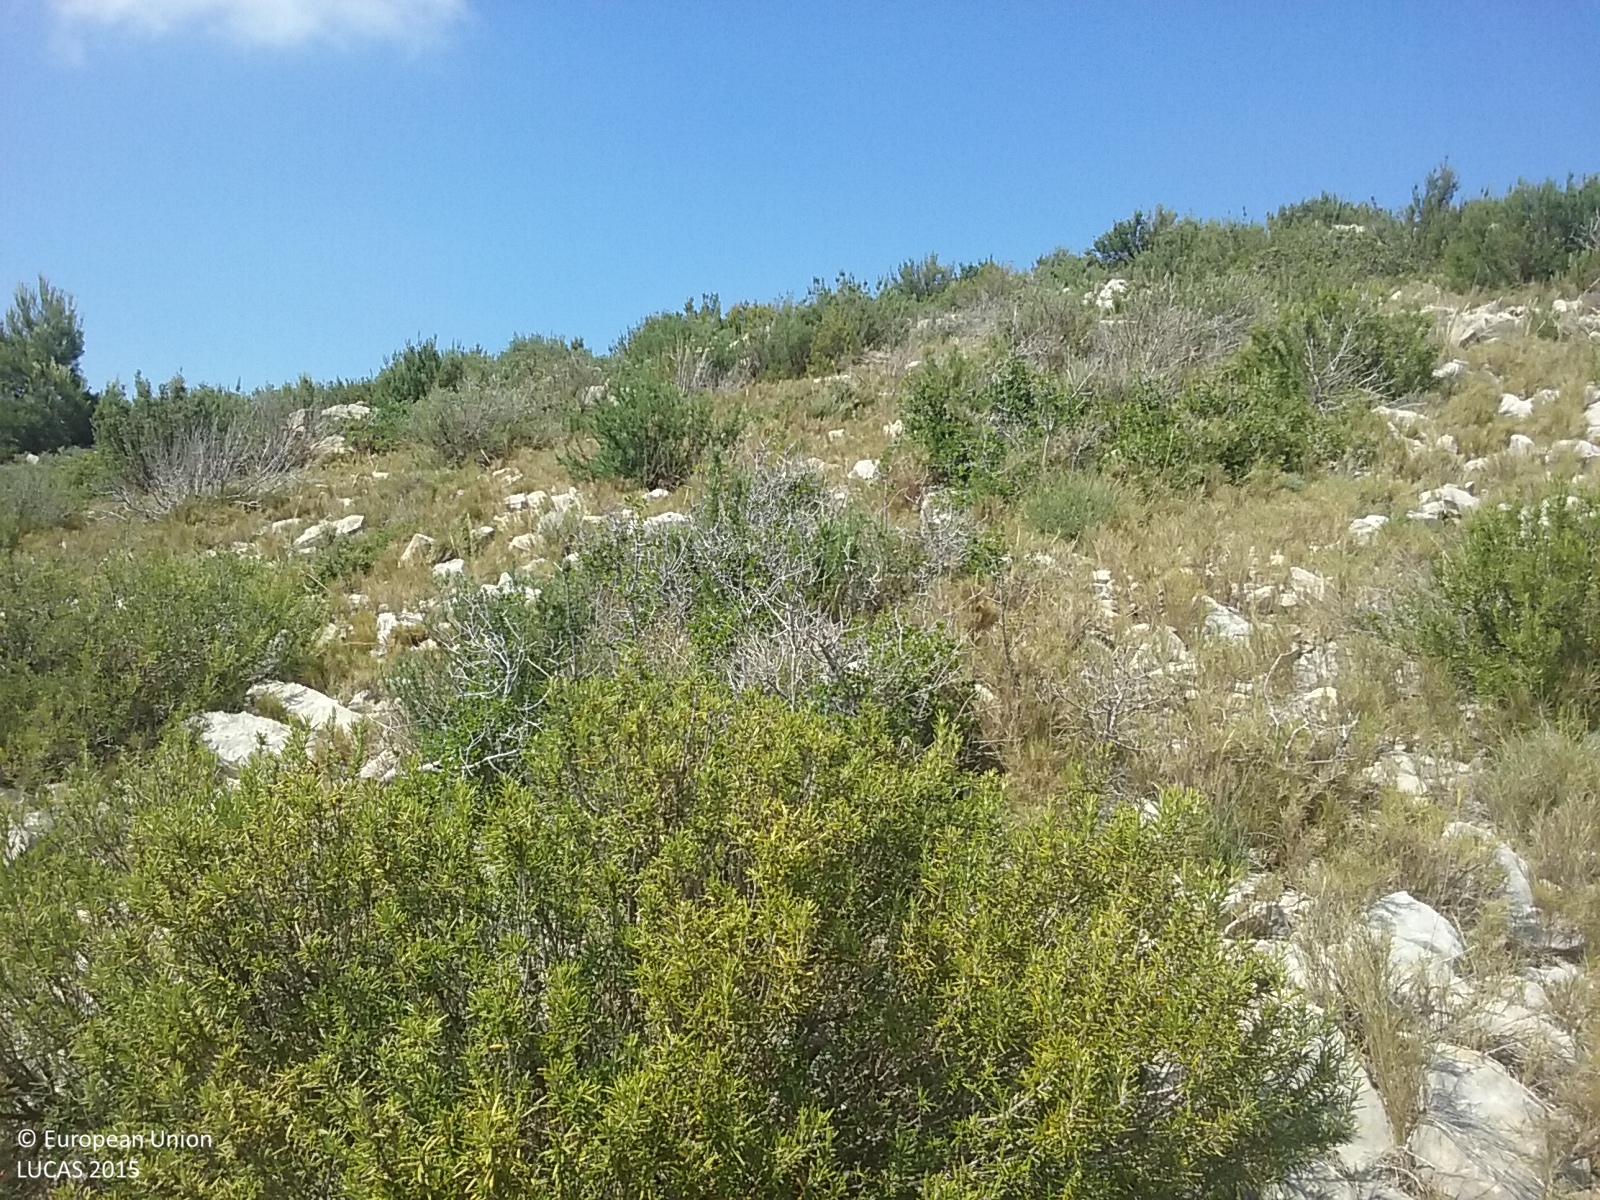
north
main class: Shrubland
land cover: Shrubland with sparse tree cover
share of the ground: > 75 %
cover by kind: shrubs 80 %, herbaceous plants 10 %, coniferous forest trees 5 %, unconsolidated bare surface 5 %
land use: Semi-natural and natural areas not in use
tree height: < 5 m
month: June
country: ES
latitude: 40.8938
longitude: 0.6524
